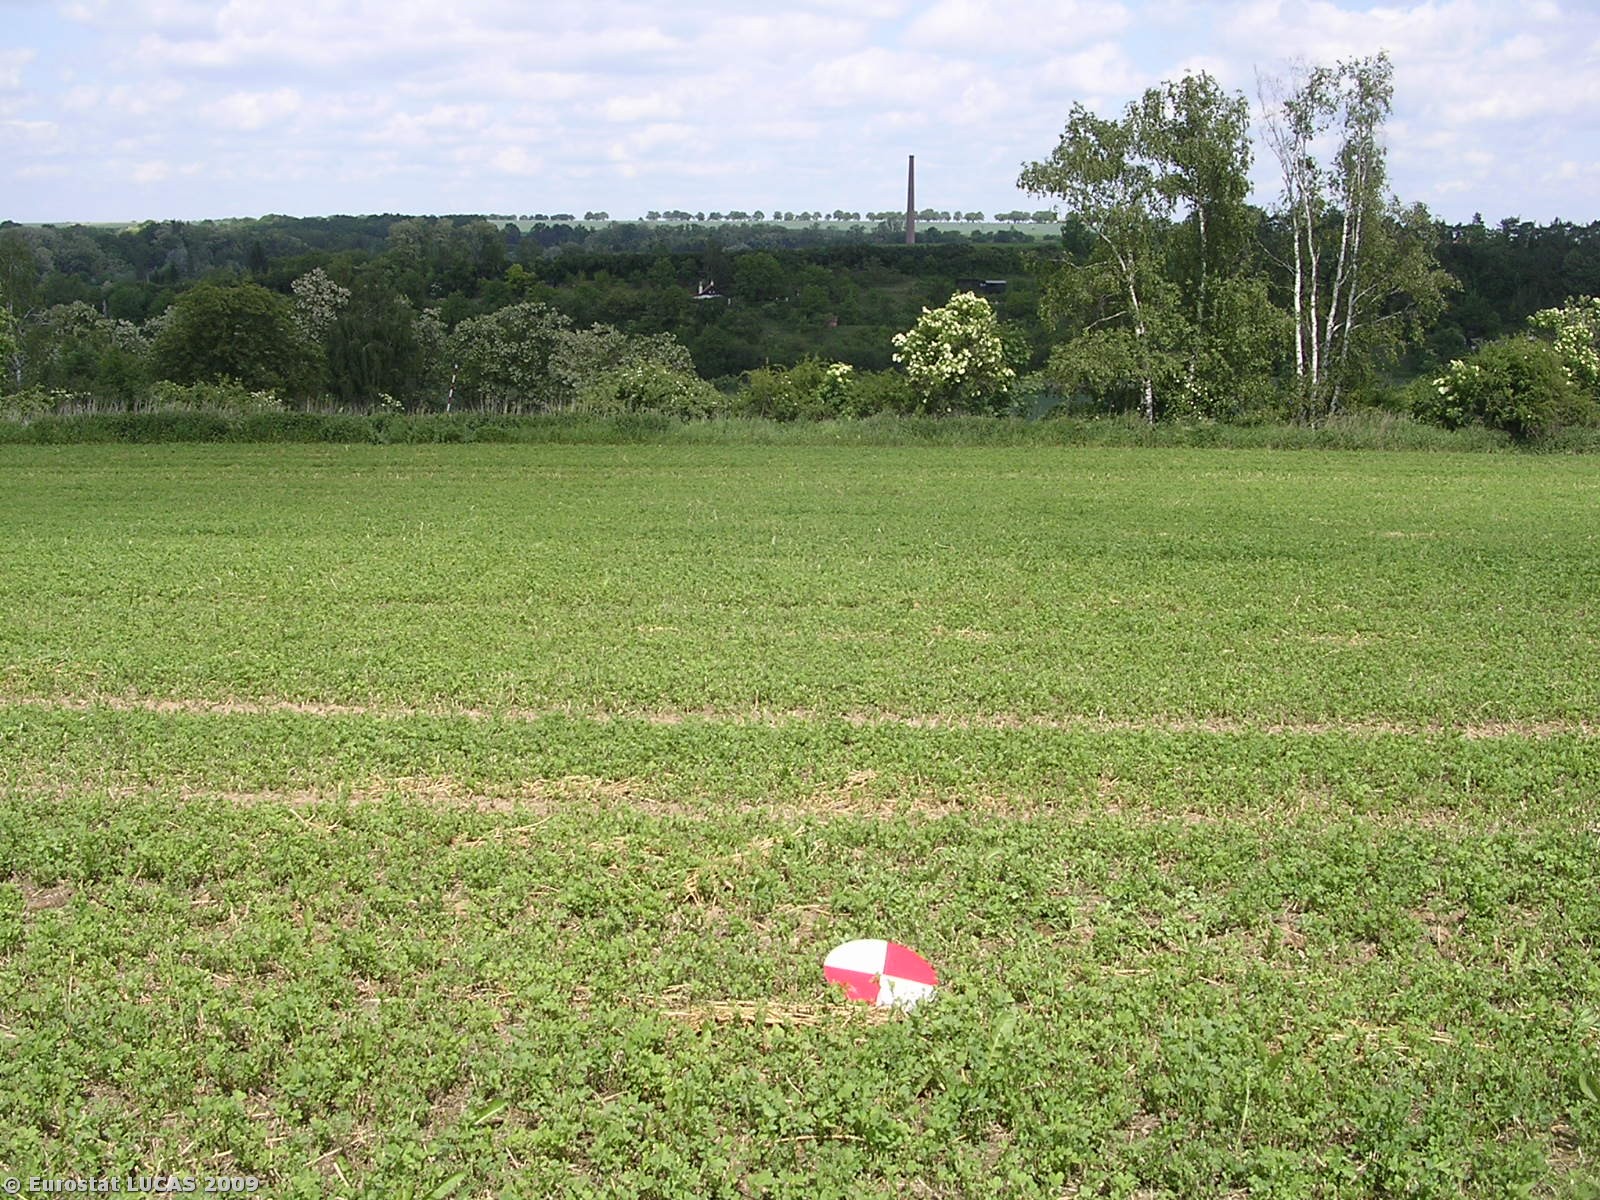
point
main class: Cropland
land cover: Lucerne
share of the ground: > 75 %
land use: Agriculture (excluding fallow land and kitchen gardens)
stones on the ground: < 10 %
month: May
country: CZ
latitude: 50.3212
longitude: 14.7073
